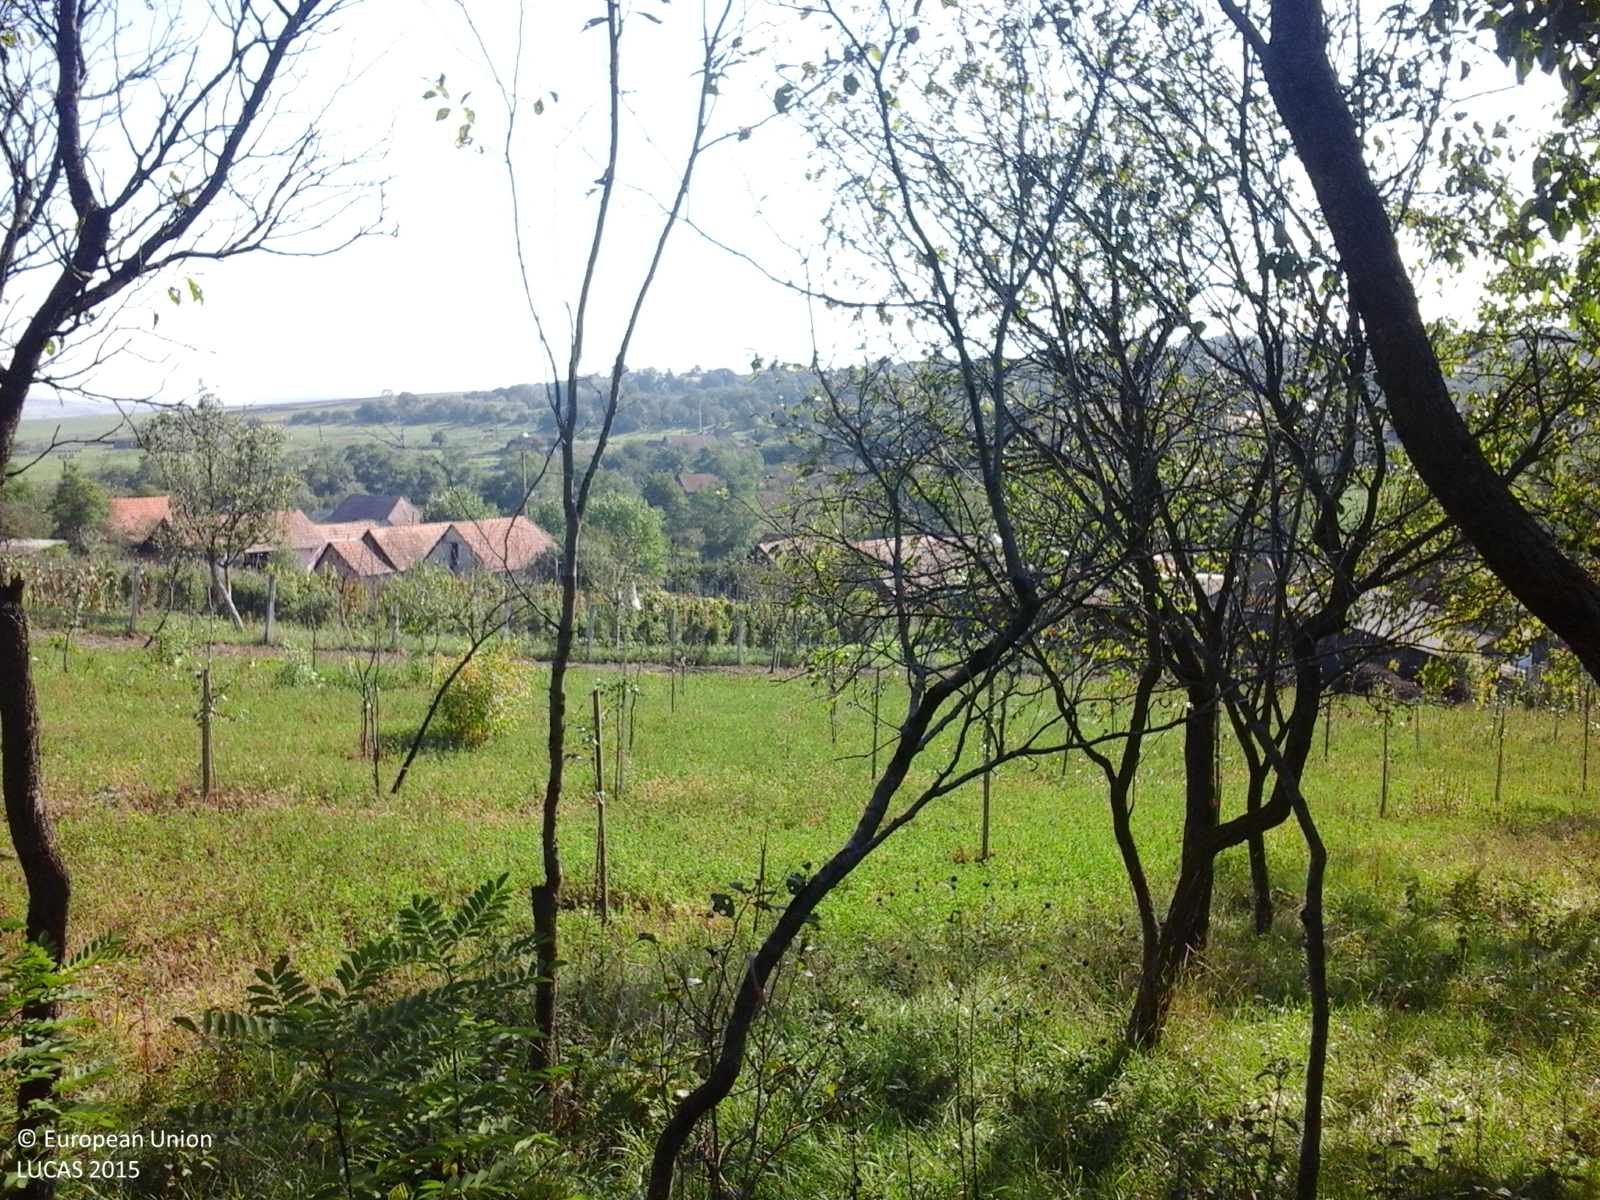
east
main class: Cropland
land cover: Other fruit trees and berries
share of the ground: 25 - 50 %
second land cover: Grassland without tree/shrub cover
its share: > 75 %
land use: Agriculture (excluding fallow land and kitchen gardens)
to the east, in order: Other fruit trees and berries; Grassland without tree/shrub cover; Lucerne; Other bare soil; Fences; Other fresh vegetables; Fences; Spontaneously vegetated surfaces; Artificial constructions in urban areas; Grassland without tree/shrub cover; Tracks; Grassland without tree/shrub cover; Electric lines; Broadleaved woodland; Ditches and canals; Tracks; Fences; Grassland without tree/shrub cover
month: October
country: RO
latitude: 46.0740
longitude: 23.7885
